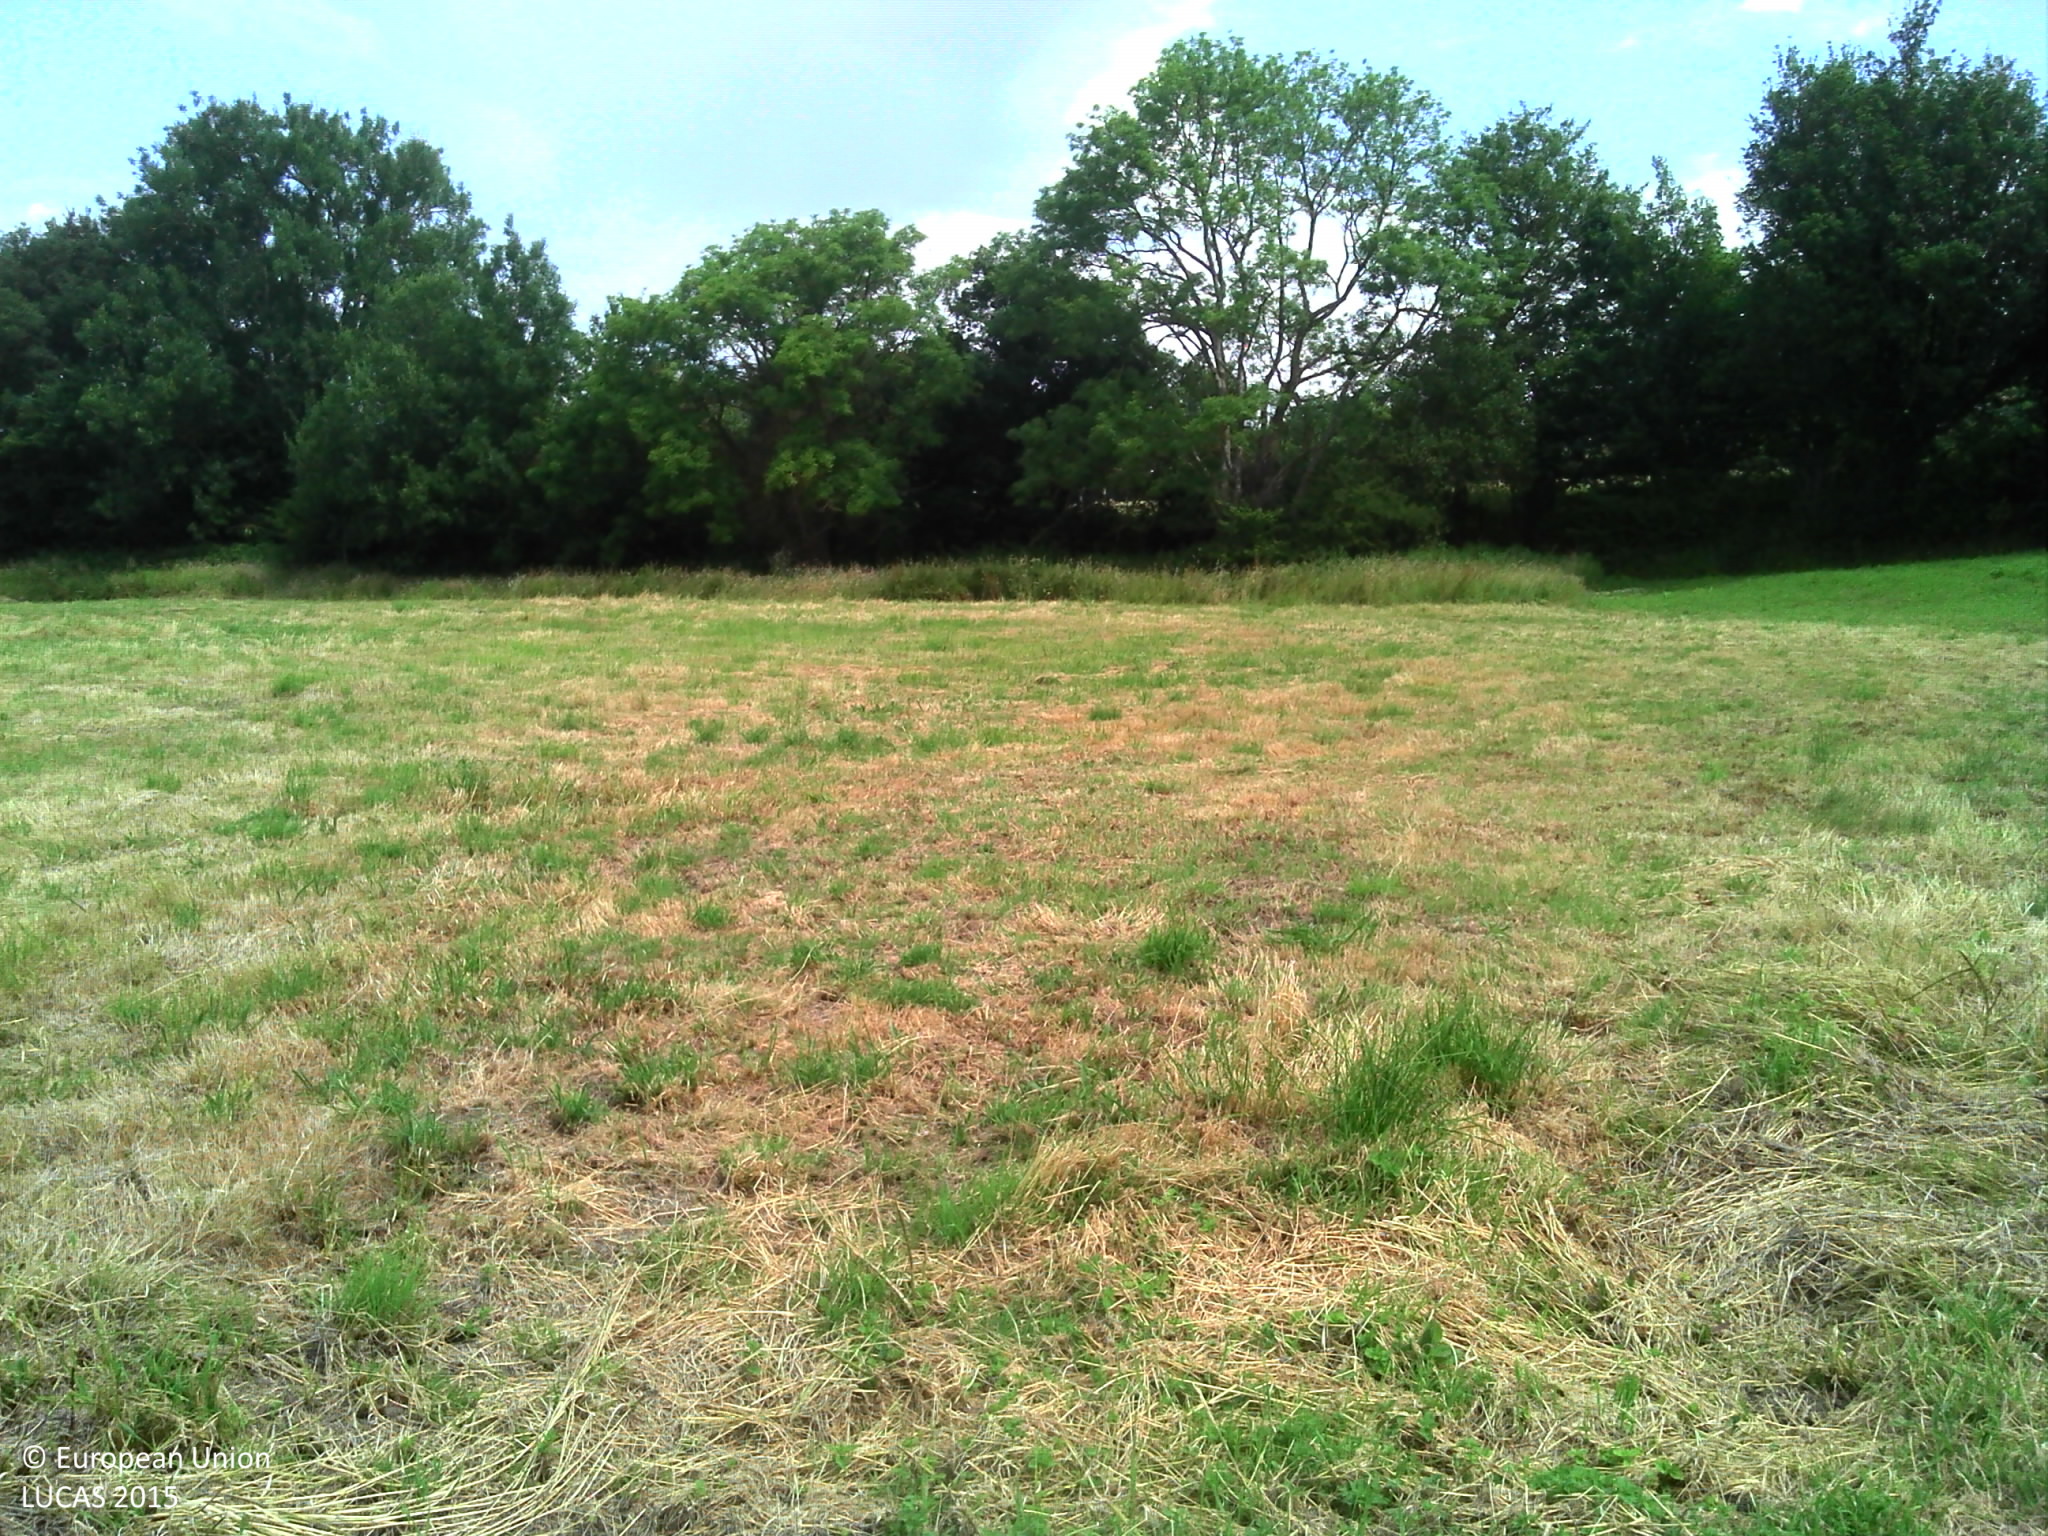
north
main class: Grassland
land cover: Grassland without tree/shrub cover
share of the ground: > 75 %
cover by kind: herbaceous plants 100 %
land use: Agriculture (excluding fallow land and kitchen gardens)
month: July
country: FR
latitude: 49.0259
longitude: 0.0823
